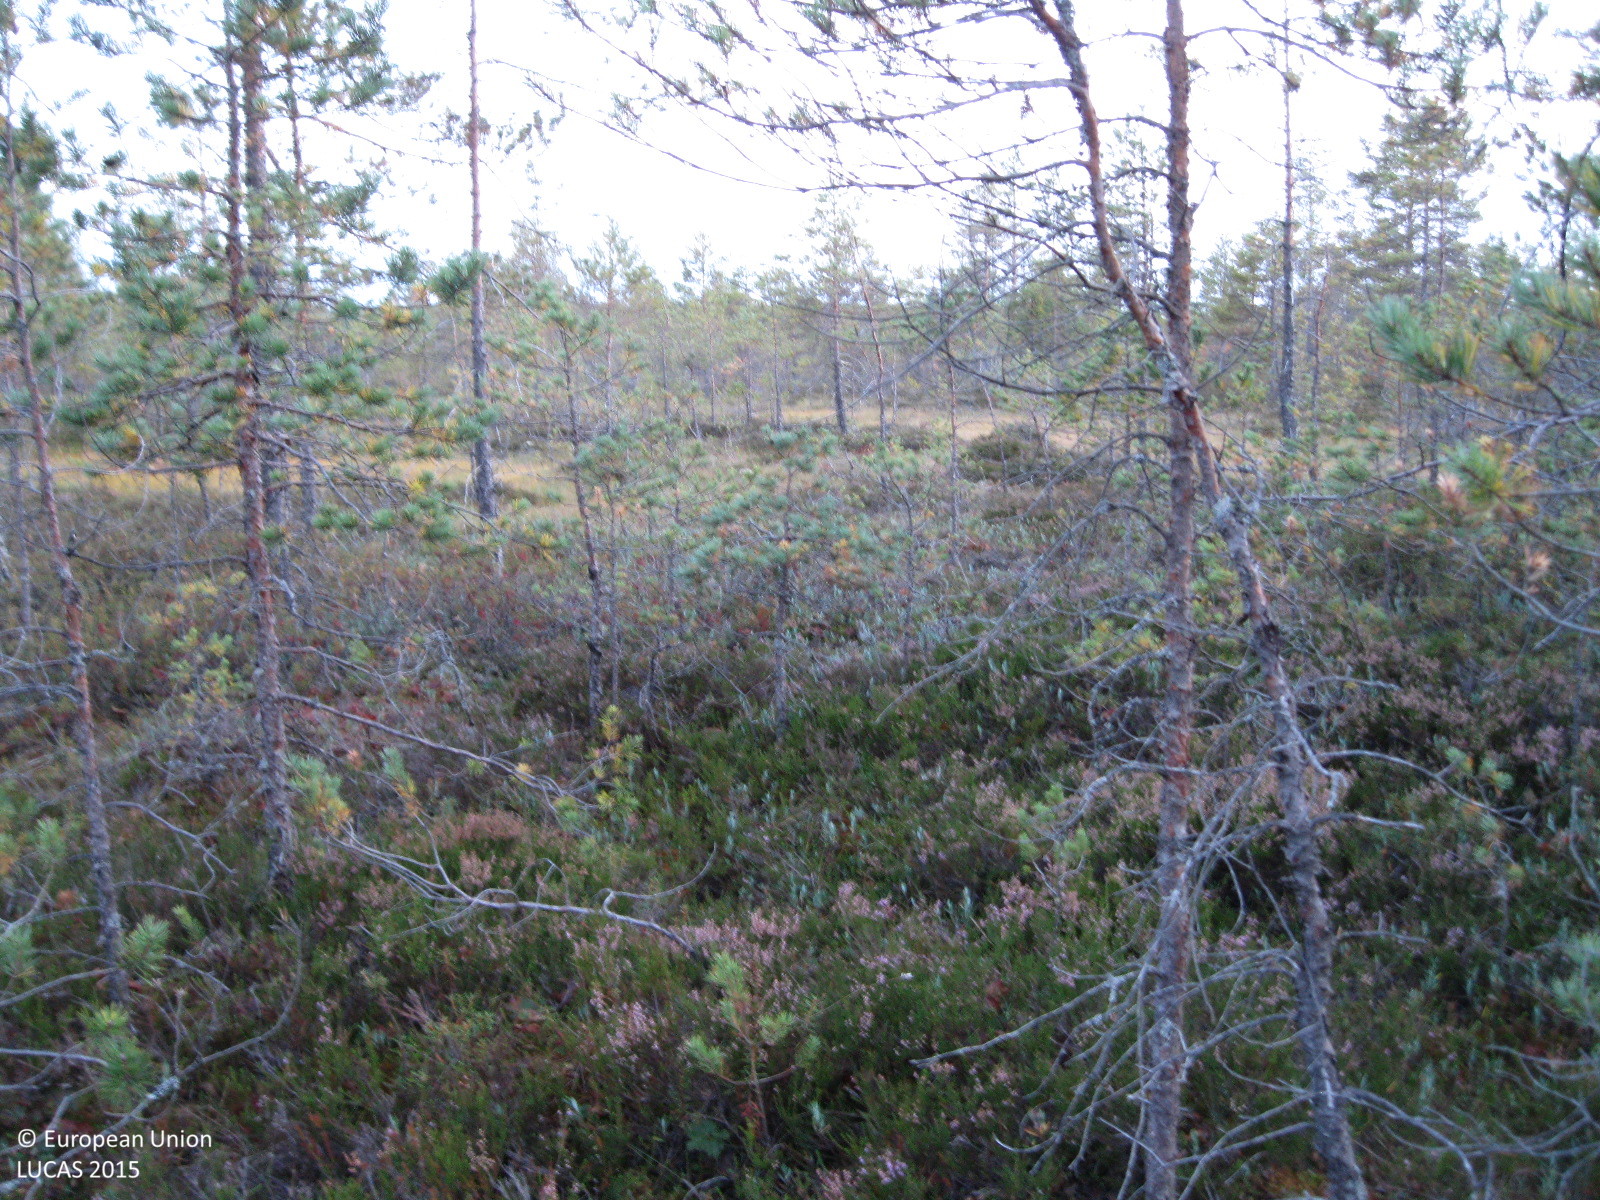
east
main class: Woodland
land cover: Pine dominated coniferous woodland
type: mire and swamp forests
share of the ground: 25 - 50 %
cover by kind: coniferous forest trees 45 %, shrubs 35 %, lichens and mosses 20 %
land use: Semi-natural and natural areas not in use
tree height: > 5 m
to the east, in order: Pine dominated coniferous woodland; Ditches and canals; Pine dominated coniferous woodland
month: September
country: FI
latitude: 60.5906
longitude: 24.7715
